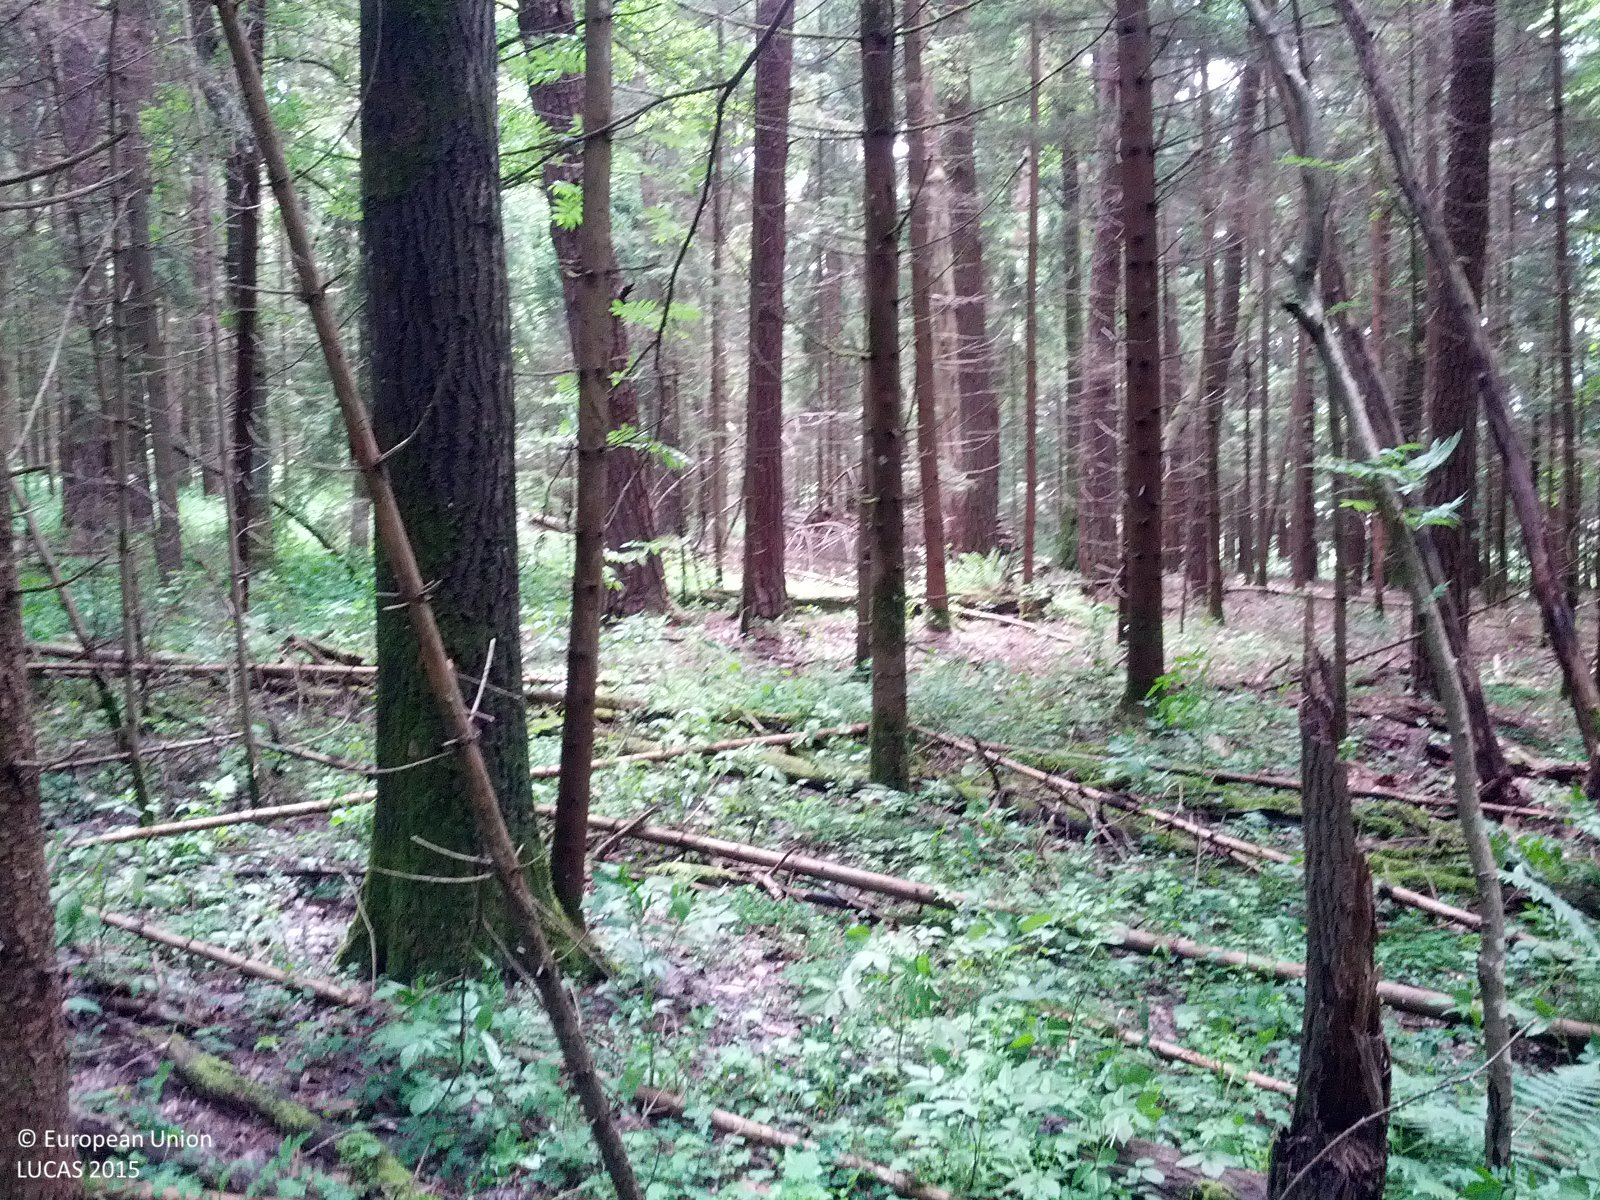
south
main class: Woodland
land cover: Spruce dominated mixed woodland
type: hemiboreal forest and nemoral coniferous forest and mixed broadleaved-coniferous forest
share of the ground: > 75 %
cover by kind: coniferous forest trees 55 %, broadleaved forest trees 25 %, shrubs 10 %, herbaceous plants 10 %
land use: Forestry
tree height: > 5 m
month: May
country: AT
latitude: 47.2981
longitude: 16.0721
